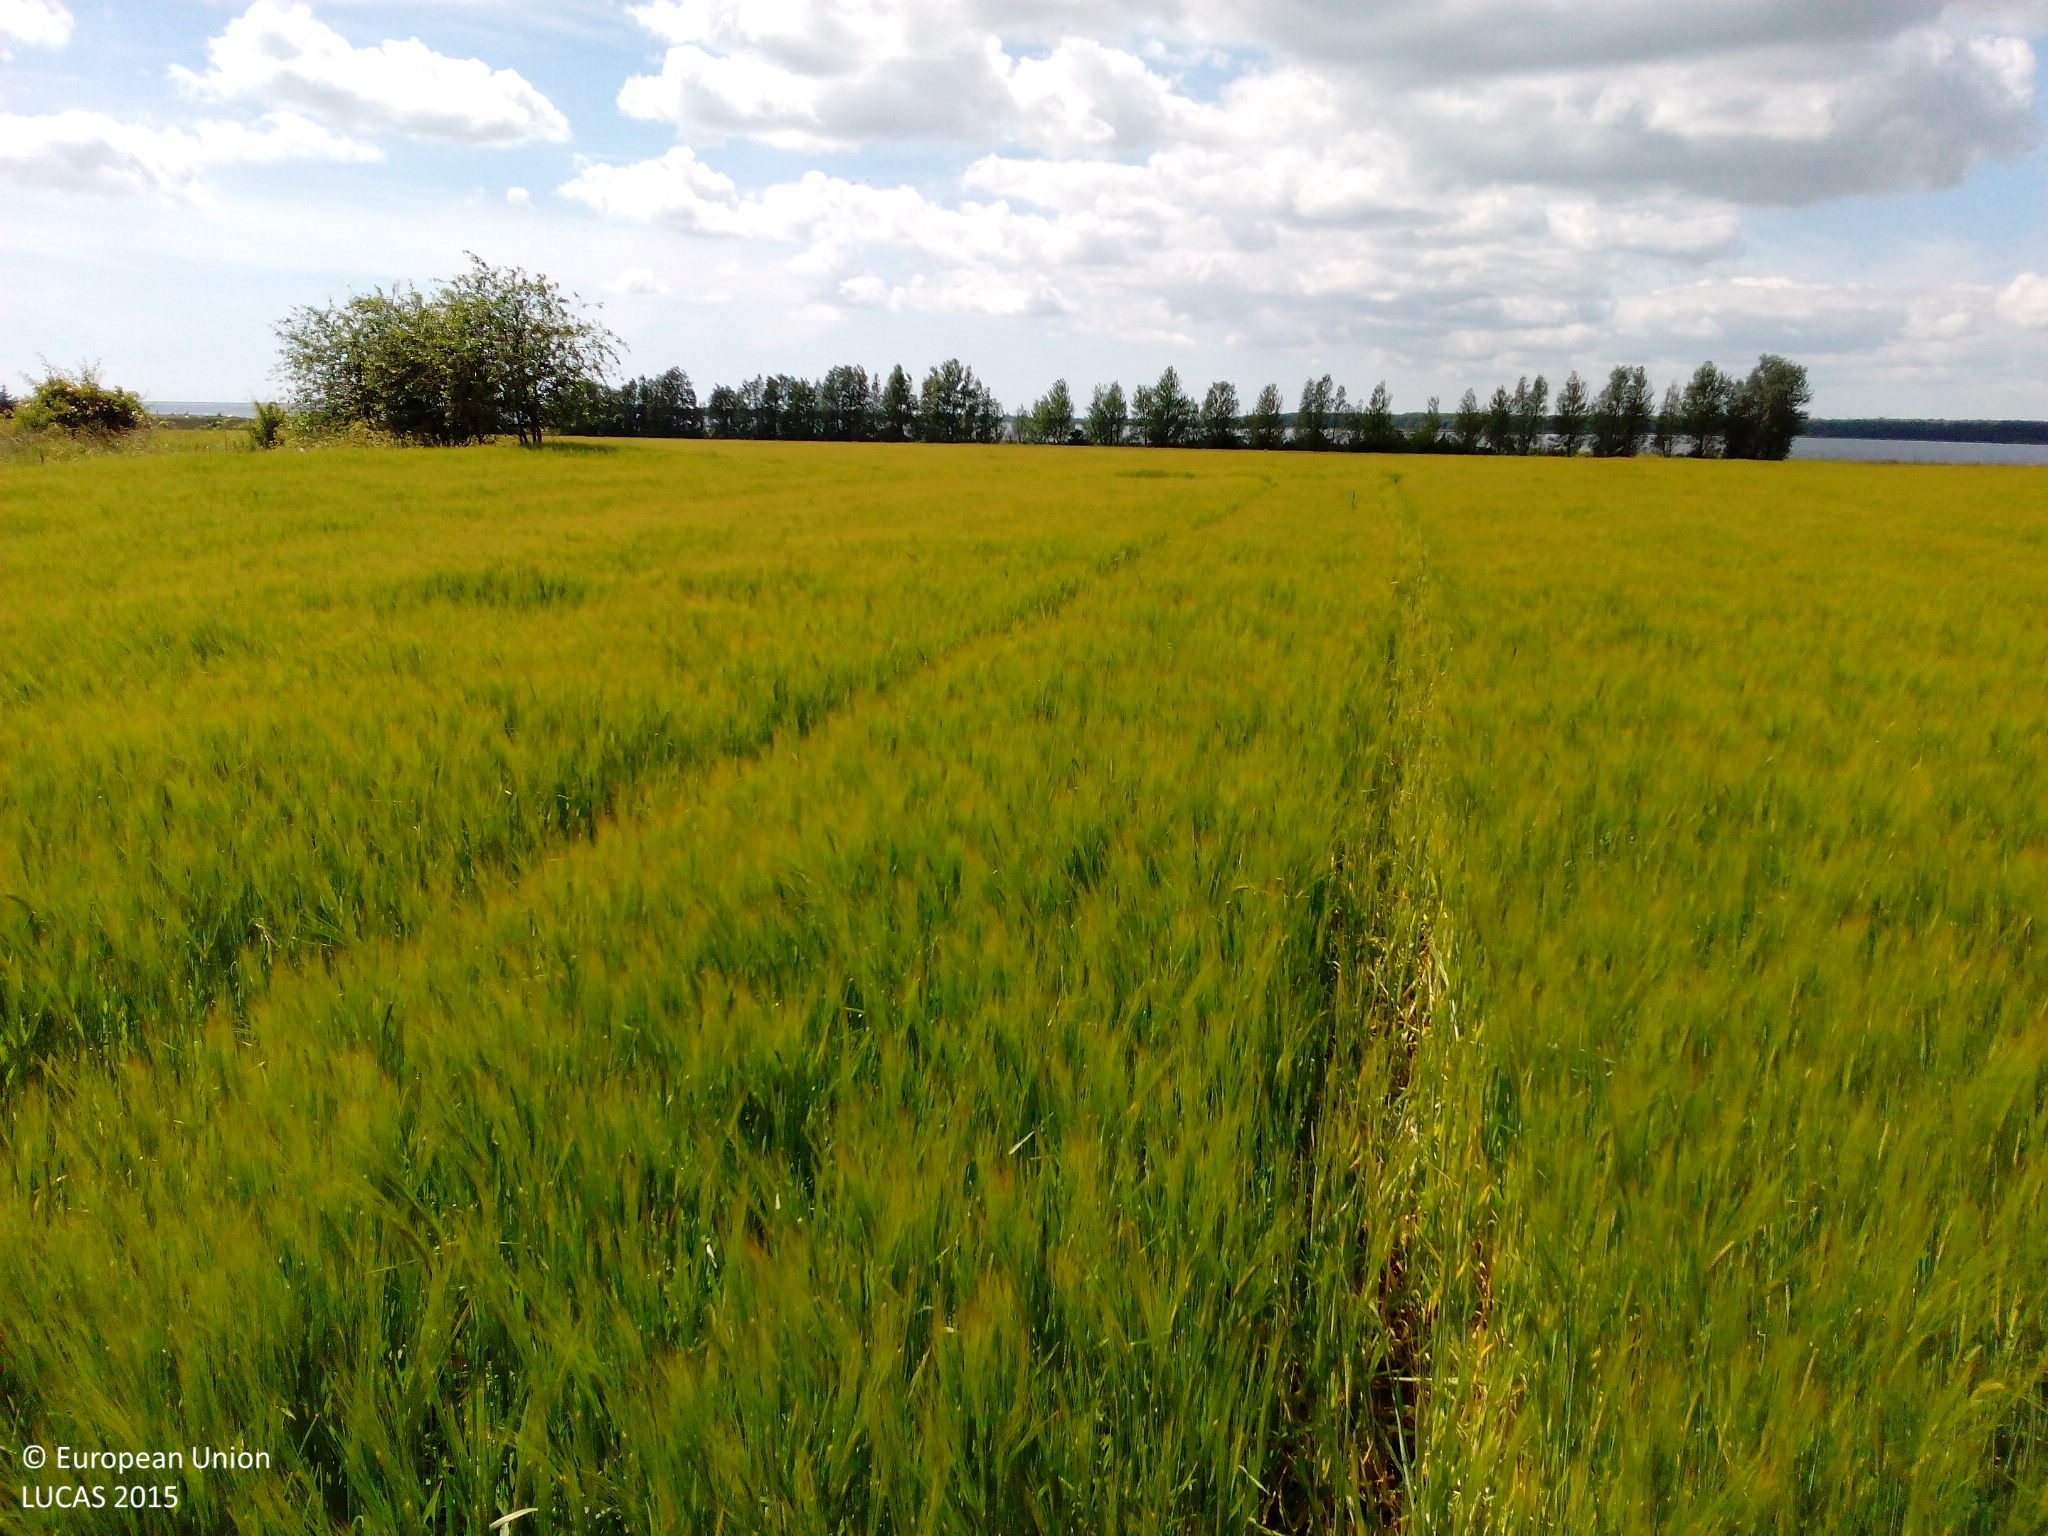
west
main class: Cropland
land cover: Barley
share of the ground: > 75 %
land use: Agriculture (excluding fallow land and kitchen gardens)
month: June
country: DK
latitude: 54.6638
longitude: 11.8748
